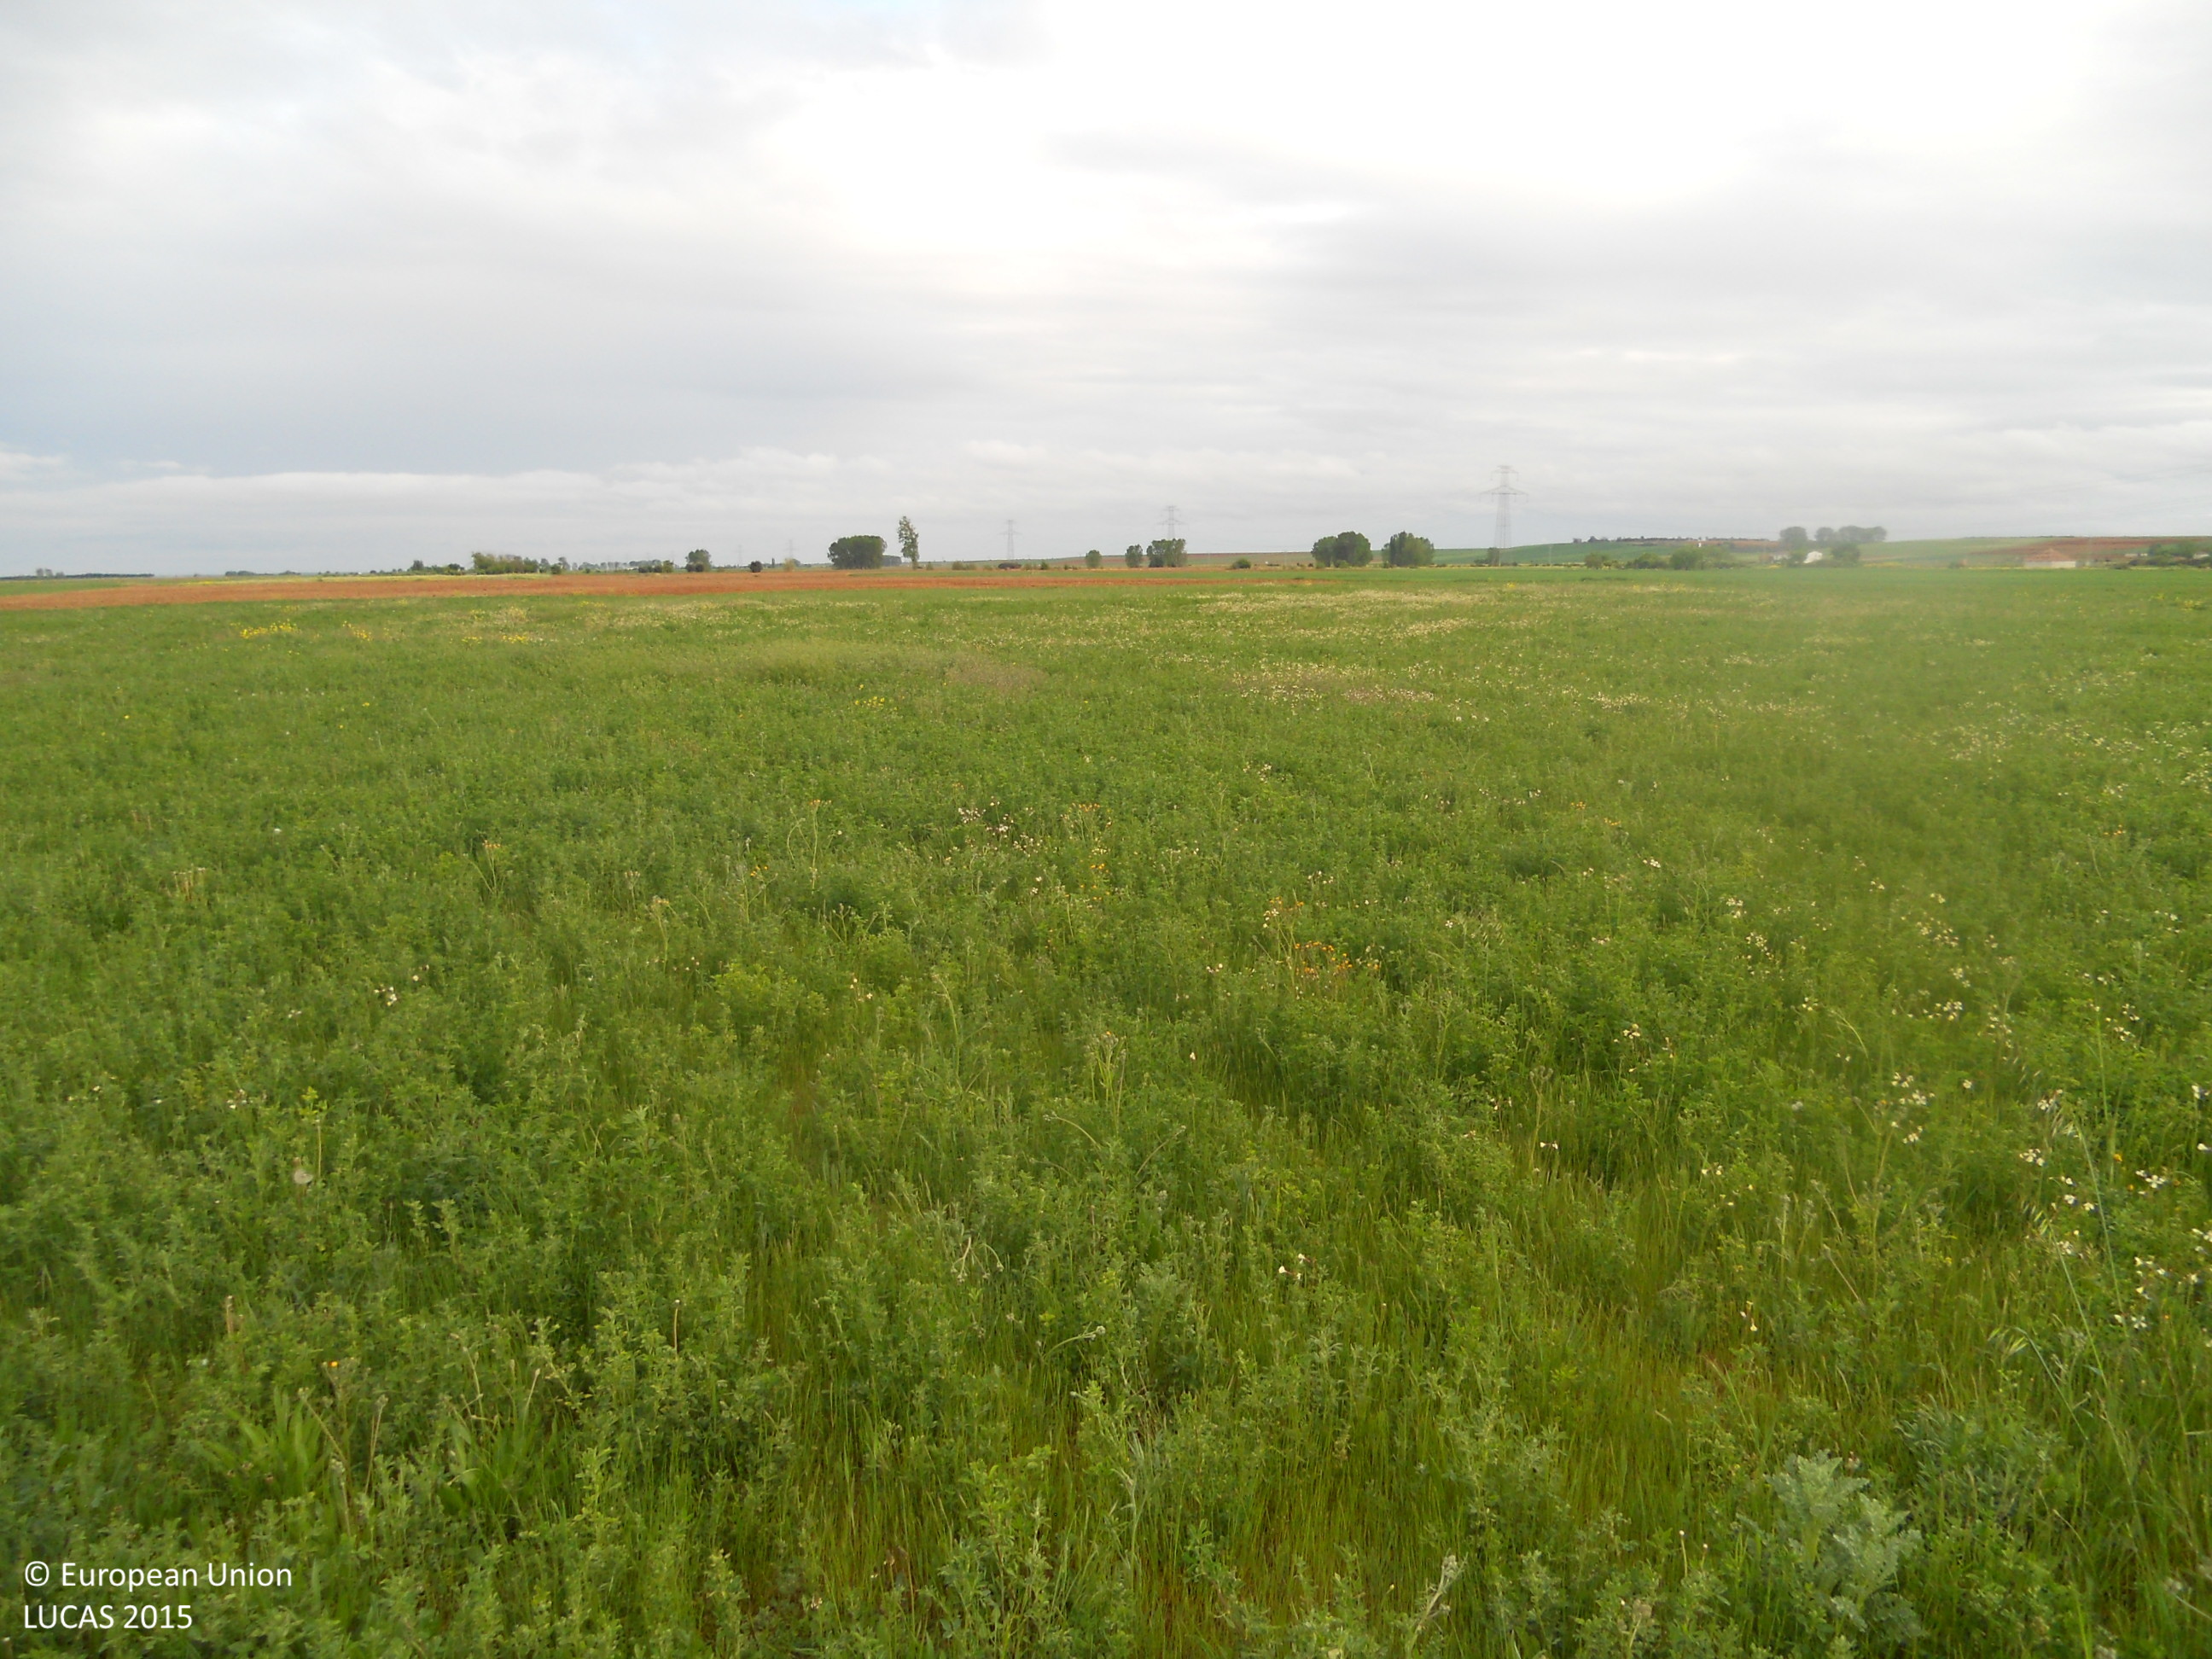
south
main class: Cropland
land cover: Lucerne
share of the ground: > 75 %
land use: Agriculture (excluding fallow land and kitchen gardens)
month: May
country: ES
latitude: 42.3109
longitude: -5.2893
